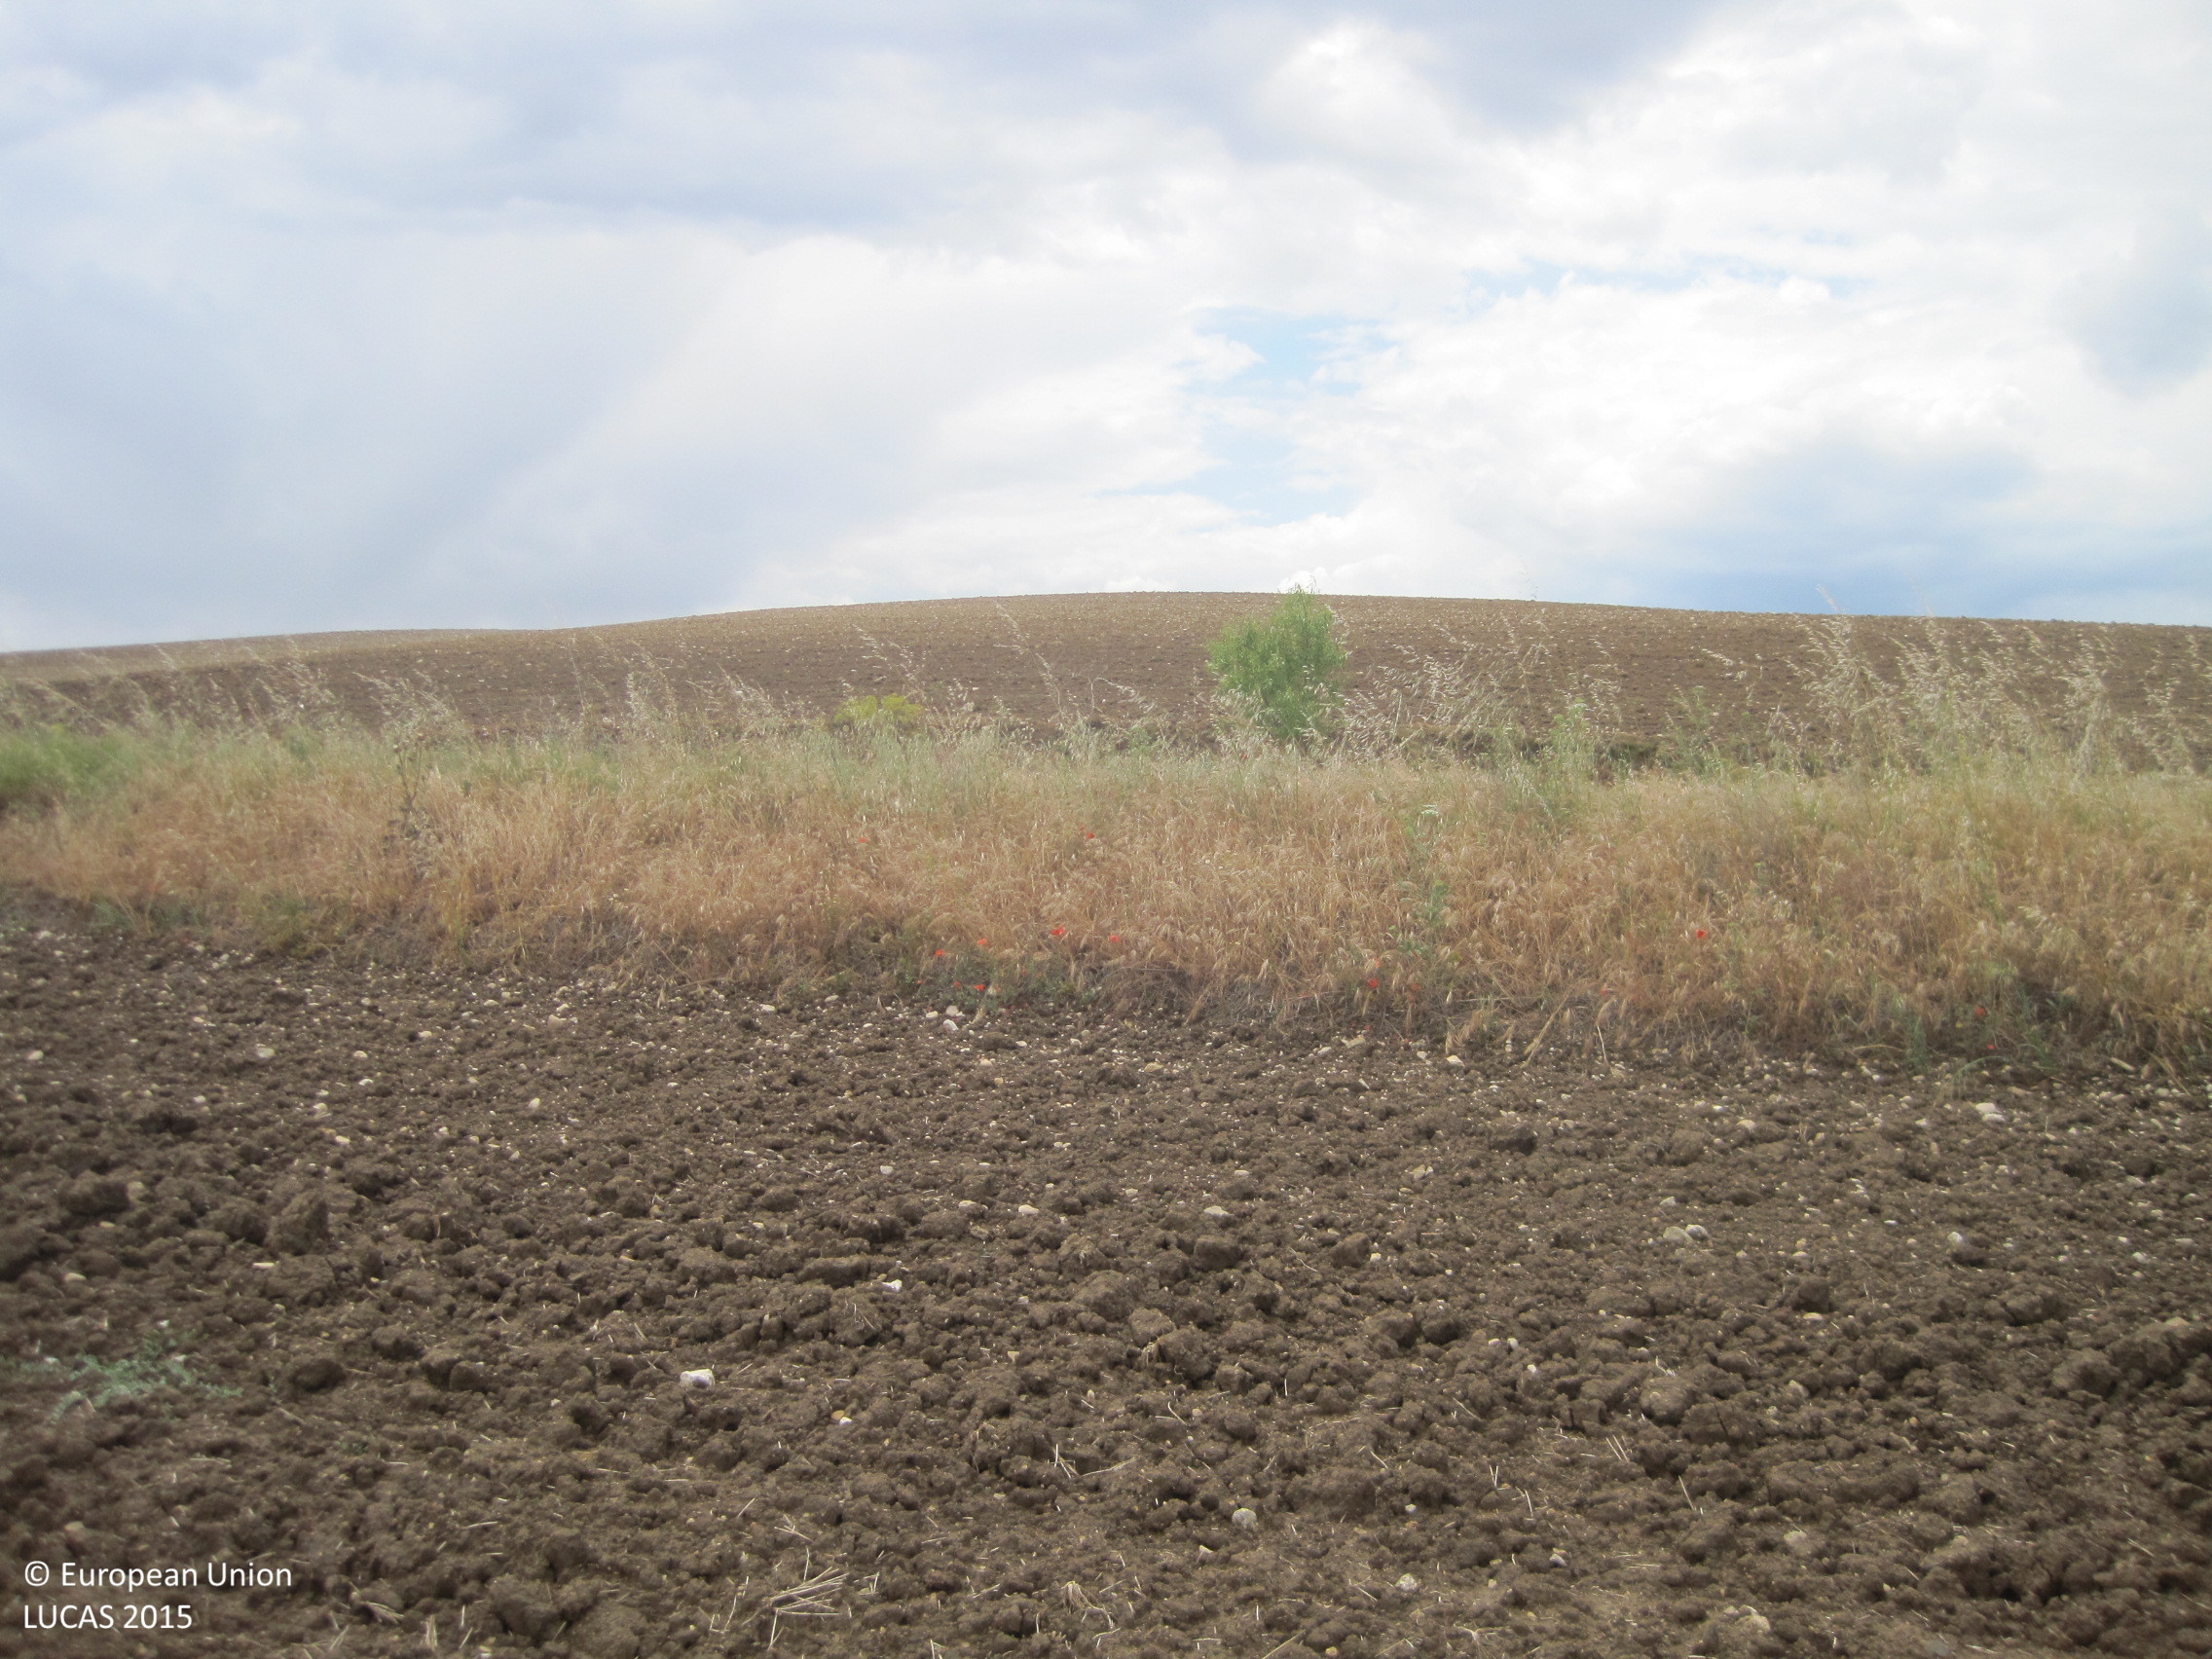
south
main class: Grassland
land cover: Spontaneously vegetated surfaces
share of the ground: 10 - 25 %
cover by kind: unconsolidated bare surface 90 %, herbaceous plants 10 %
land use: Fallow land
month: June
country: ES
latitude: 42.5034
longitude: -2.1500
